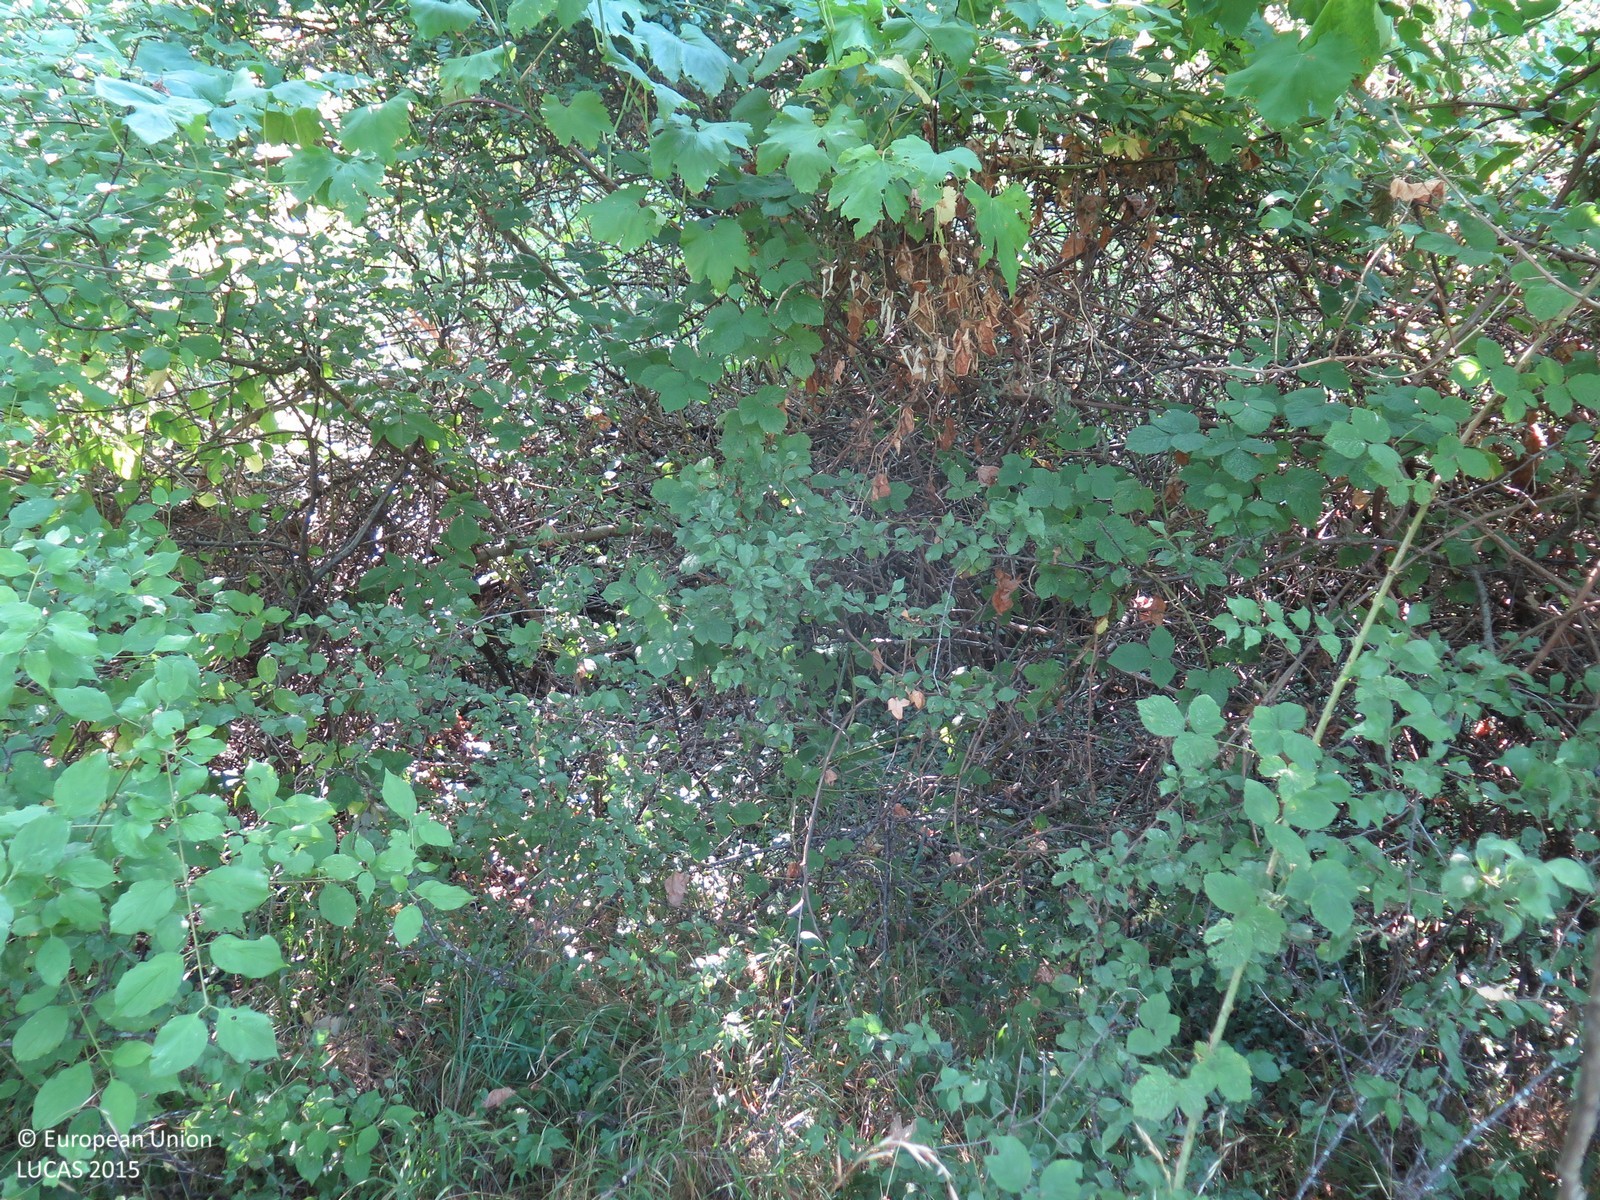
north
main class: Shrubland
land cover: Shrubland with sparse tree cover
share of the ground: > 75 %
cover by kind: shrubs 90 %, broadleaved forest trees 5 %, herbaceous plants 5 %
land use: Semi-natural and natural areas not in use
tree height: > 5 m
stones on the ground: < 10 %
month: August
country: HR
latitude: 45.2389
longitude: 14.2368
